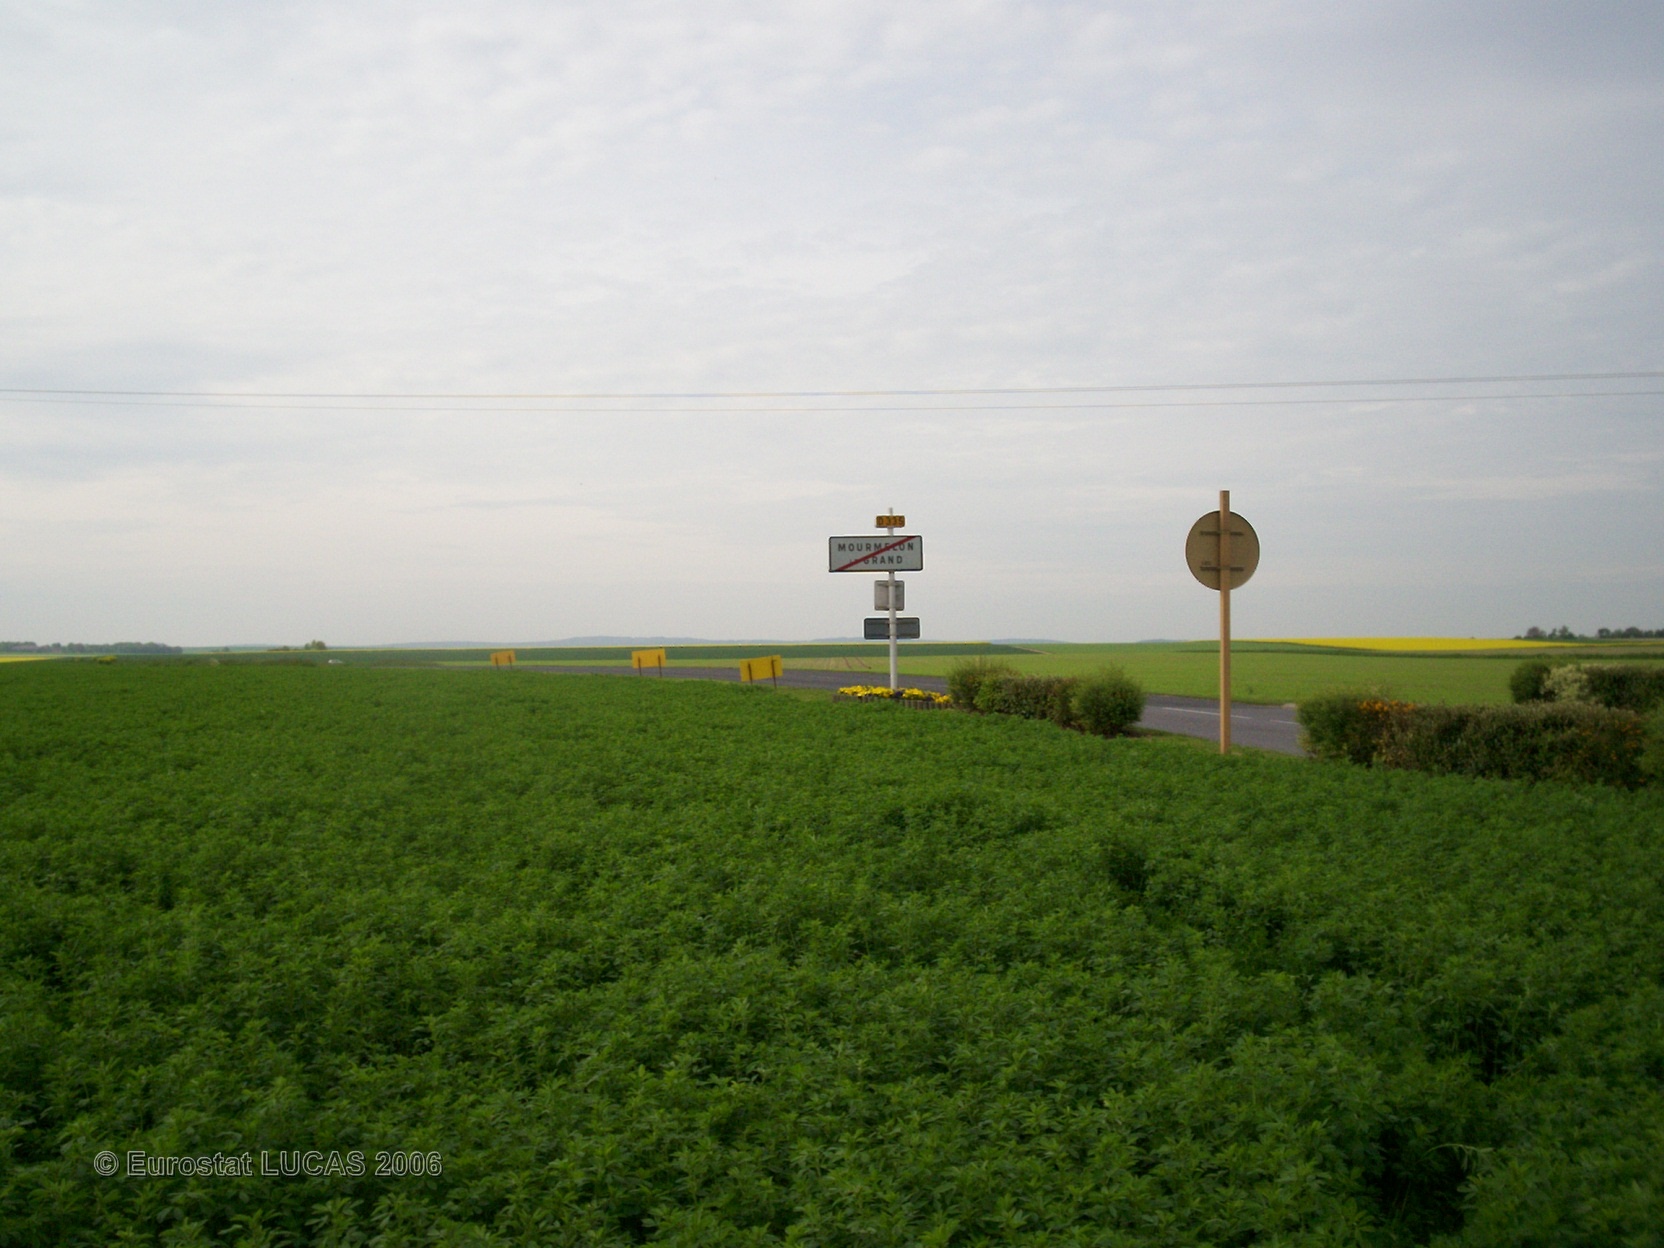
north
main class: Cropland
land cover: Lucerne
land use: Agriculture (excluding fallow land and kitchen gardens)
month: May
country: FR
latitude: 49.1433
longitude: 4.3620
